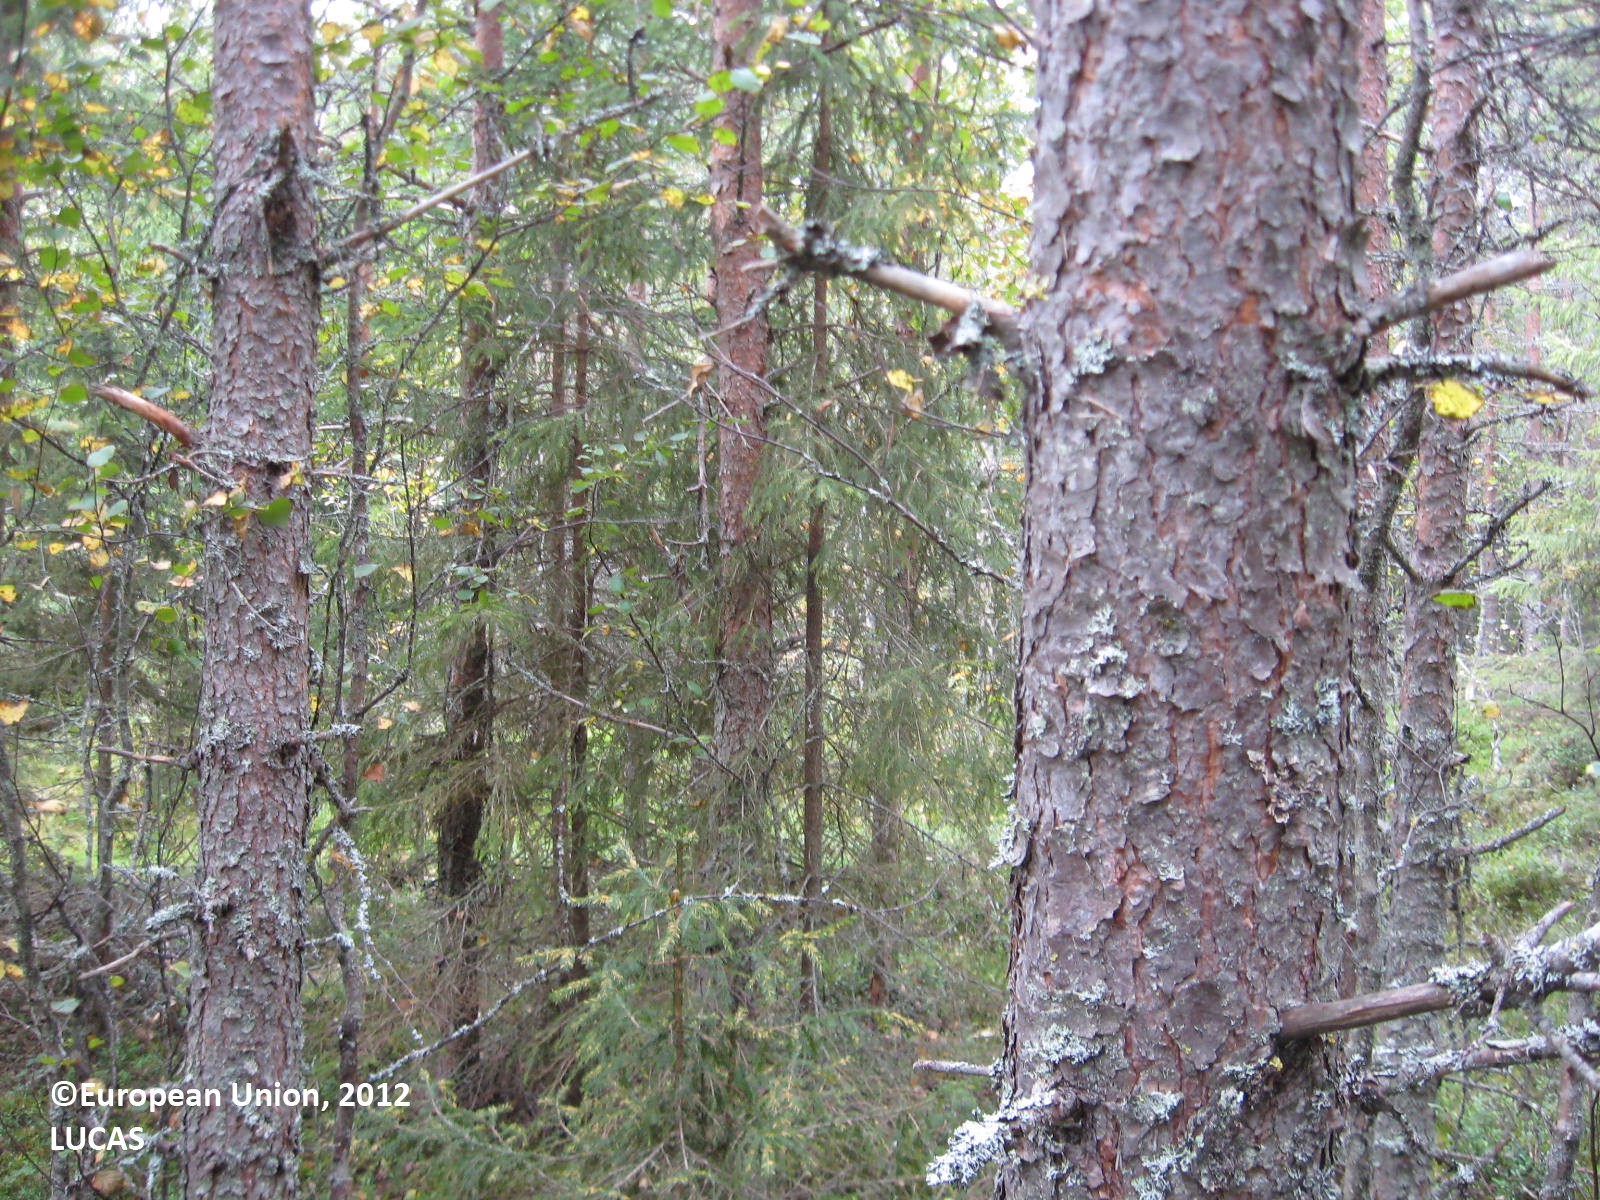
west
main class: Woodland
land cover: Pine dominated mixed woodland
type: boreal forest
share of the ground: > 75 %
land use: Forestry
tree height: > 5 m
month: August
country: FI
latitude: 63.5467
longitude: 30.3215
